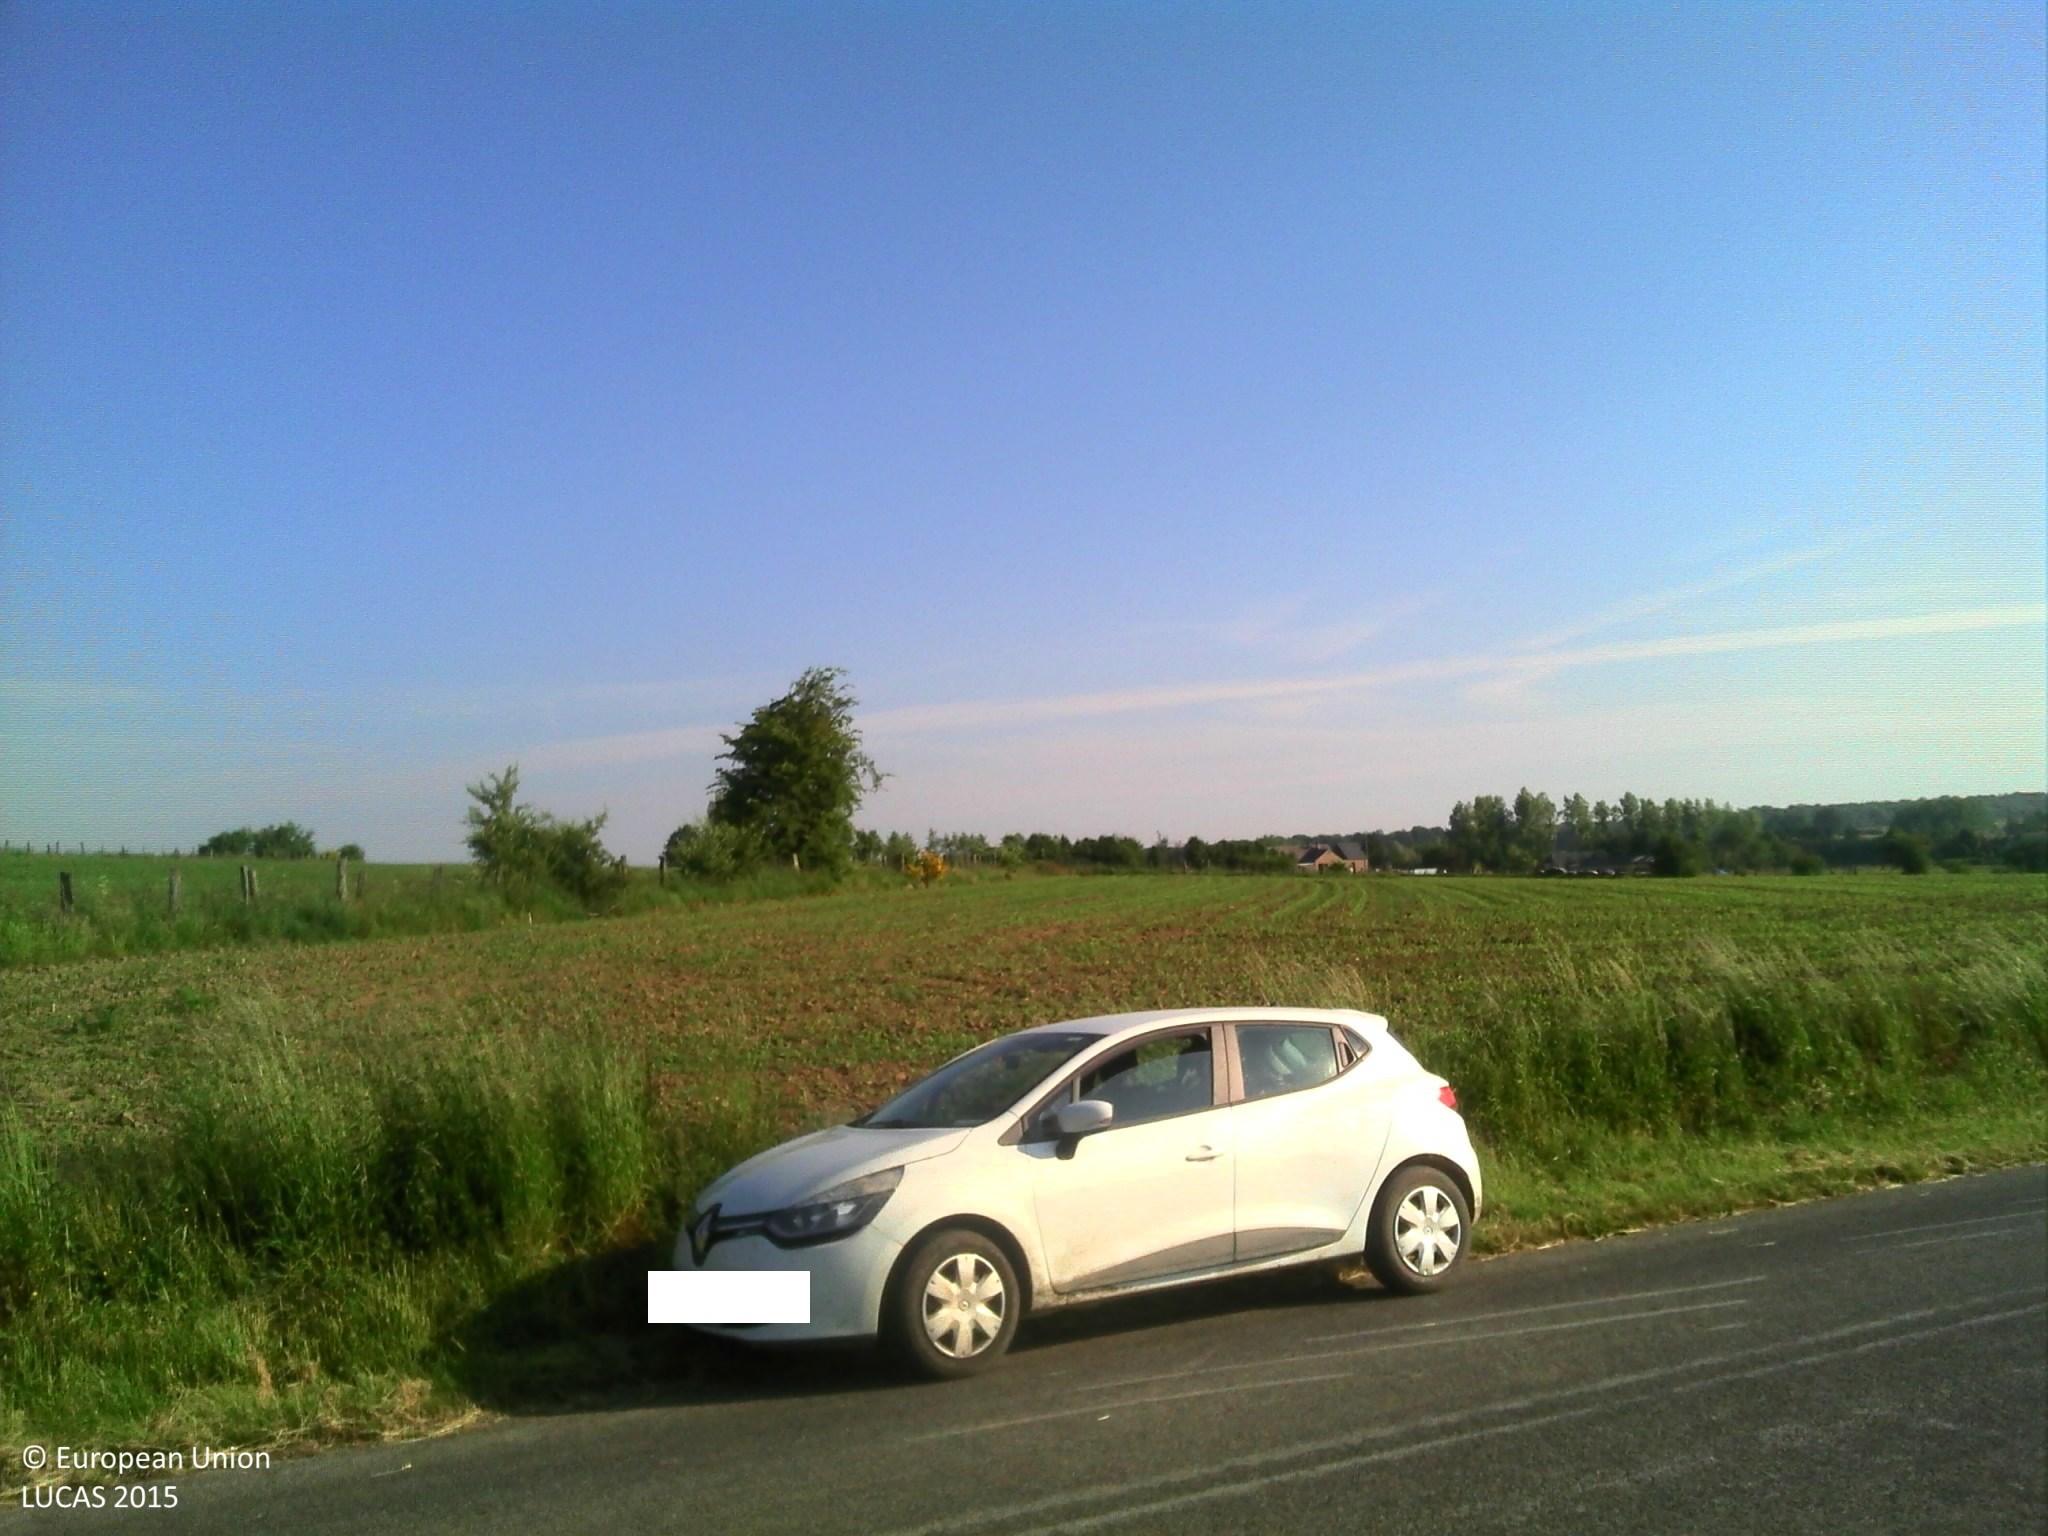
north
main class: Grassland
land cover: Grassland without tree/shrub cover
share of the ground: > 75 %
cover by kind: herbaceous plants 100 %
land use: Agriculture (excluding fallow land and kitchen gardens)
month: June
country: BE
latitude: 49.9028
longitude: 5.1943
